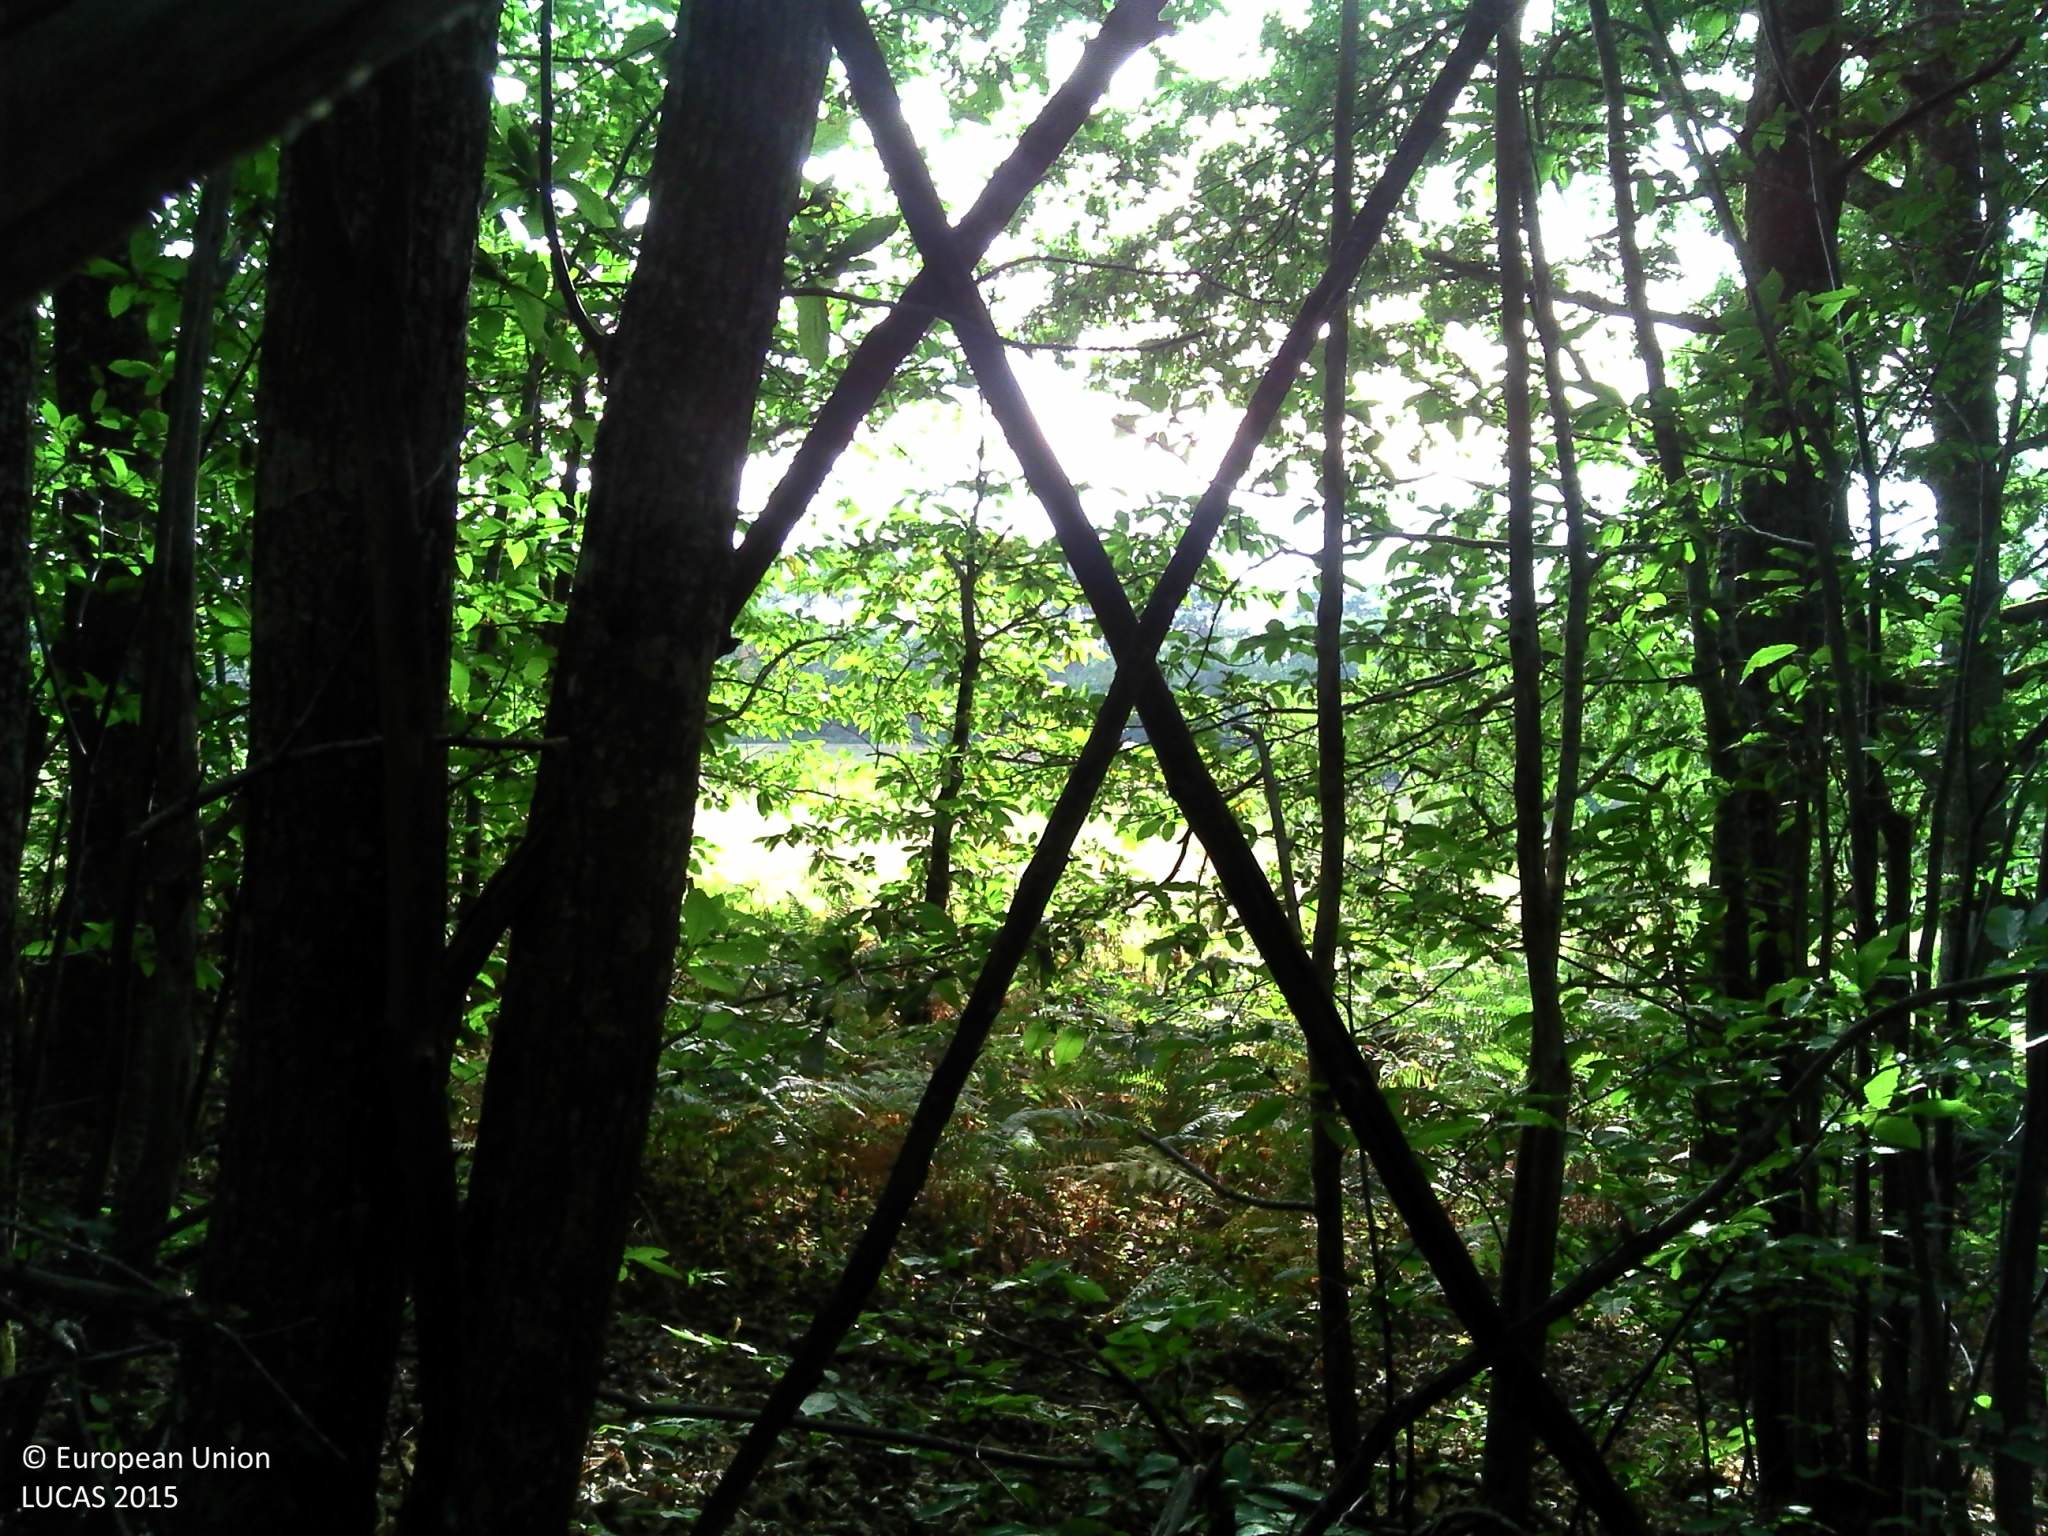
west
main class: Woodland
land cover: Broadleaved woodland
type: thermophilous deciduous forest
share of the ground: > 75 %
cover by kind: broadleaved forest trees 80 %, shrubs 10 %, herbaceous plants 5 %, lichens and mosses 5 %
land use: Forestry
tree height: > 5 m
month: July
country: FR
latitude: 45.0262
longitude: 0.5599
